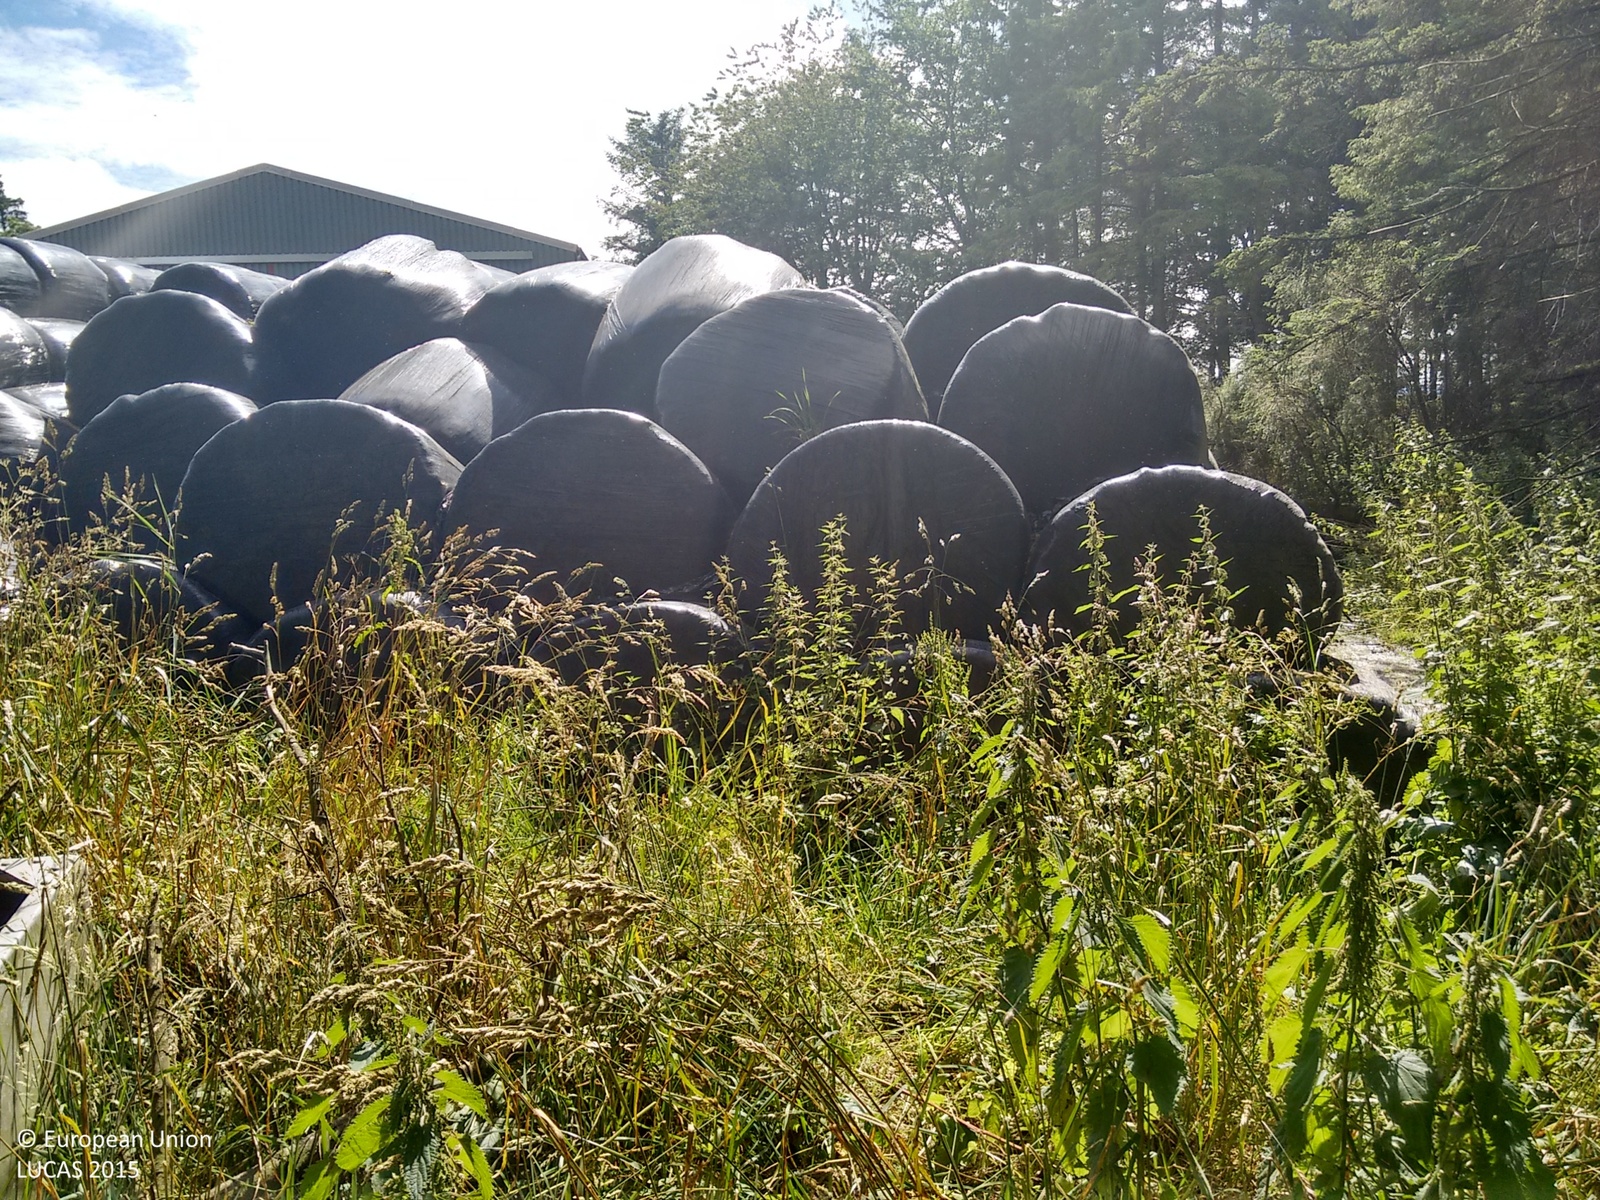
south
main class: Woodland
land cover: Spruce dominated coniferous woodland
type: exotic forest
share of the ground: > 75 %
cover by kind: coniferous forest trees 70 %, herbaceous plants 10 %, broadleaved forest trees 5 %, shrubs 5 %
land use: Agriculture (excluding fallow land and kitchen gardens)
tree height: > 5 m
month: August
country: GB
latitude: 57.5679
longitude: -2.9838
